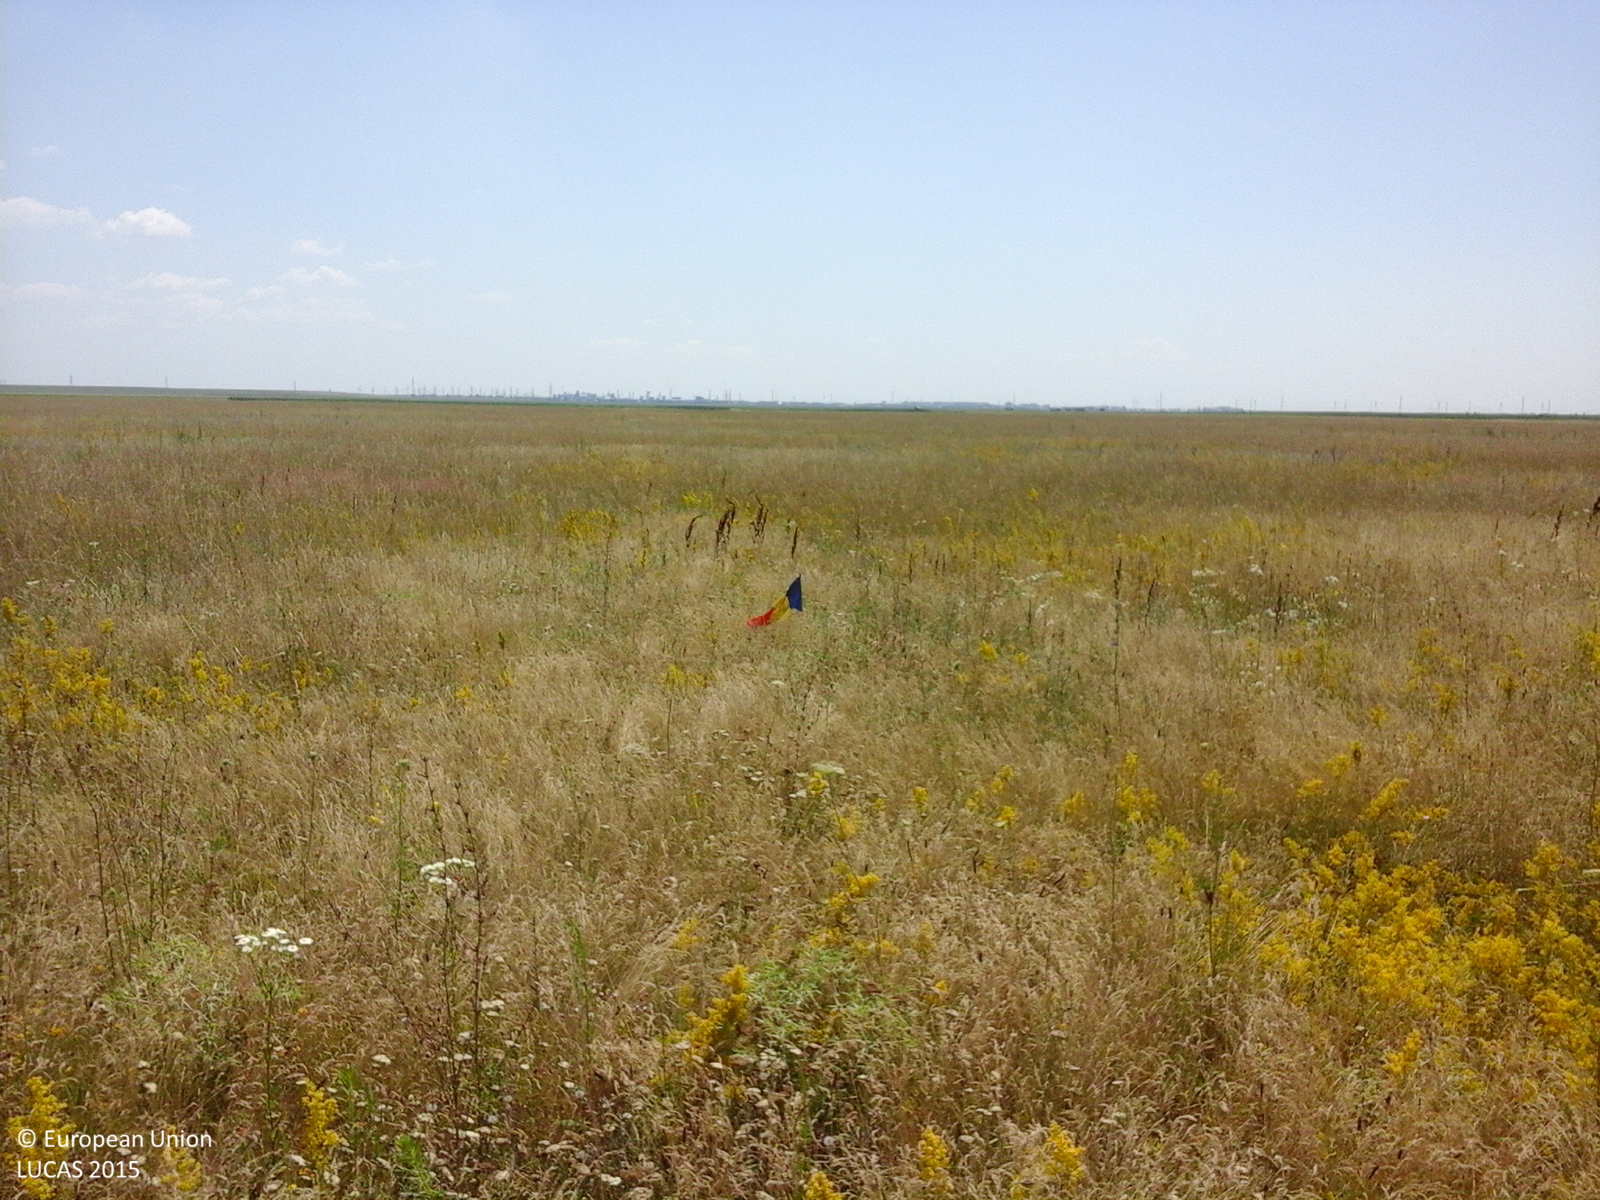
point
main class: Grassland
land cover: Spontaneously vegetated surfaces
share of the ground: > 75 %
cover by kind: herbaceous plants 100 %
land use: Fallow land
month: July
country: RO
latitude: 44.5148
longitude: 24.3724
